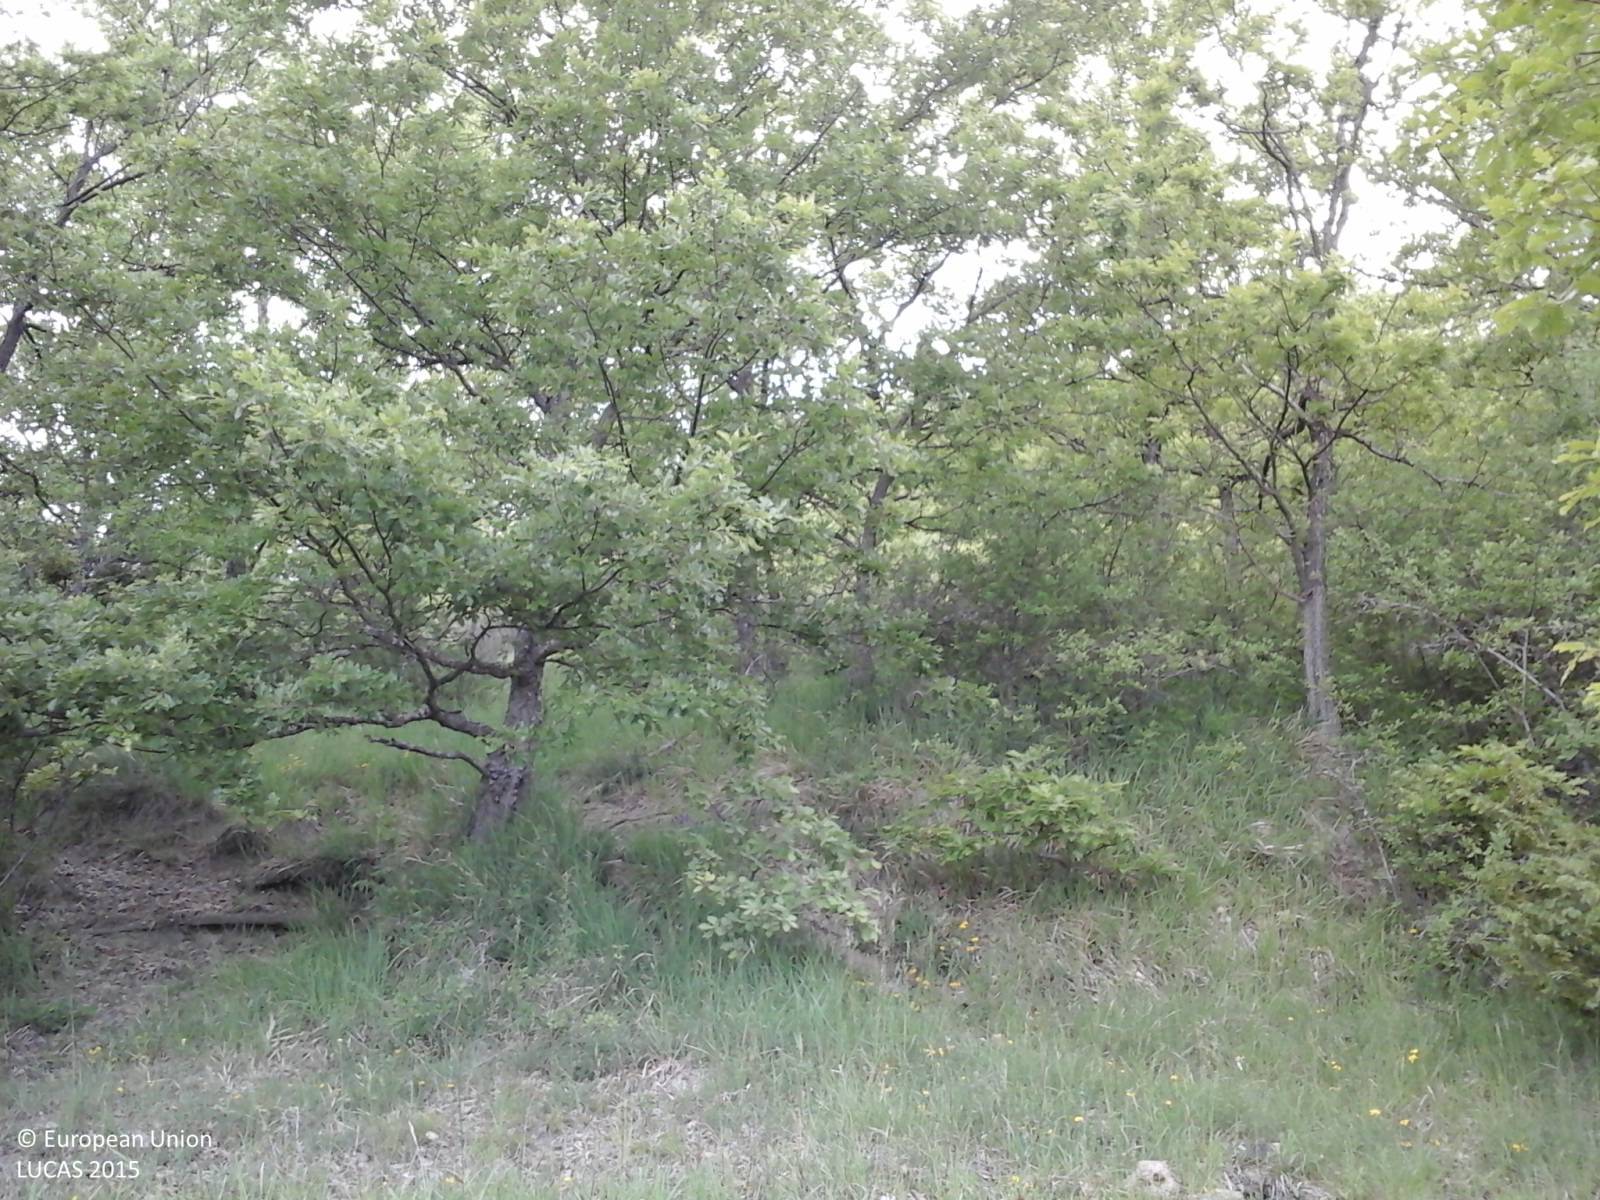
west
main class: Woodland
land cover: Broadleaved woodland
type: thermophilous deciduous forest
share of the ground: 10 - 25 %
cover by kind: herbaceous plants 80 %, broadleaved forest trees 10 %, shrubs 10 %
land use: Agriculture (excluding fallow land and kitchen gardens)
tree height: < 5 m
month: May
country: IT
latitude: 41.8439
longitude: 14.1889
